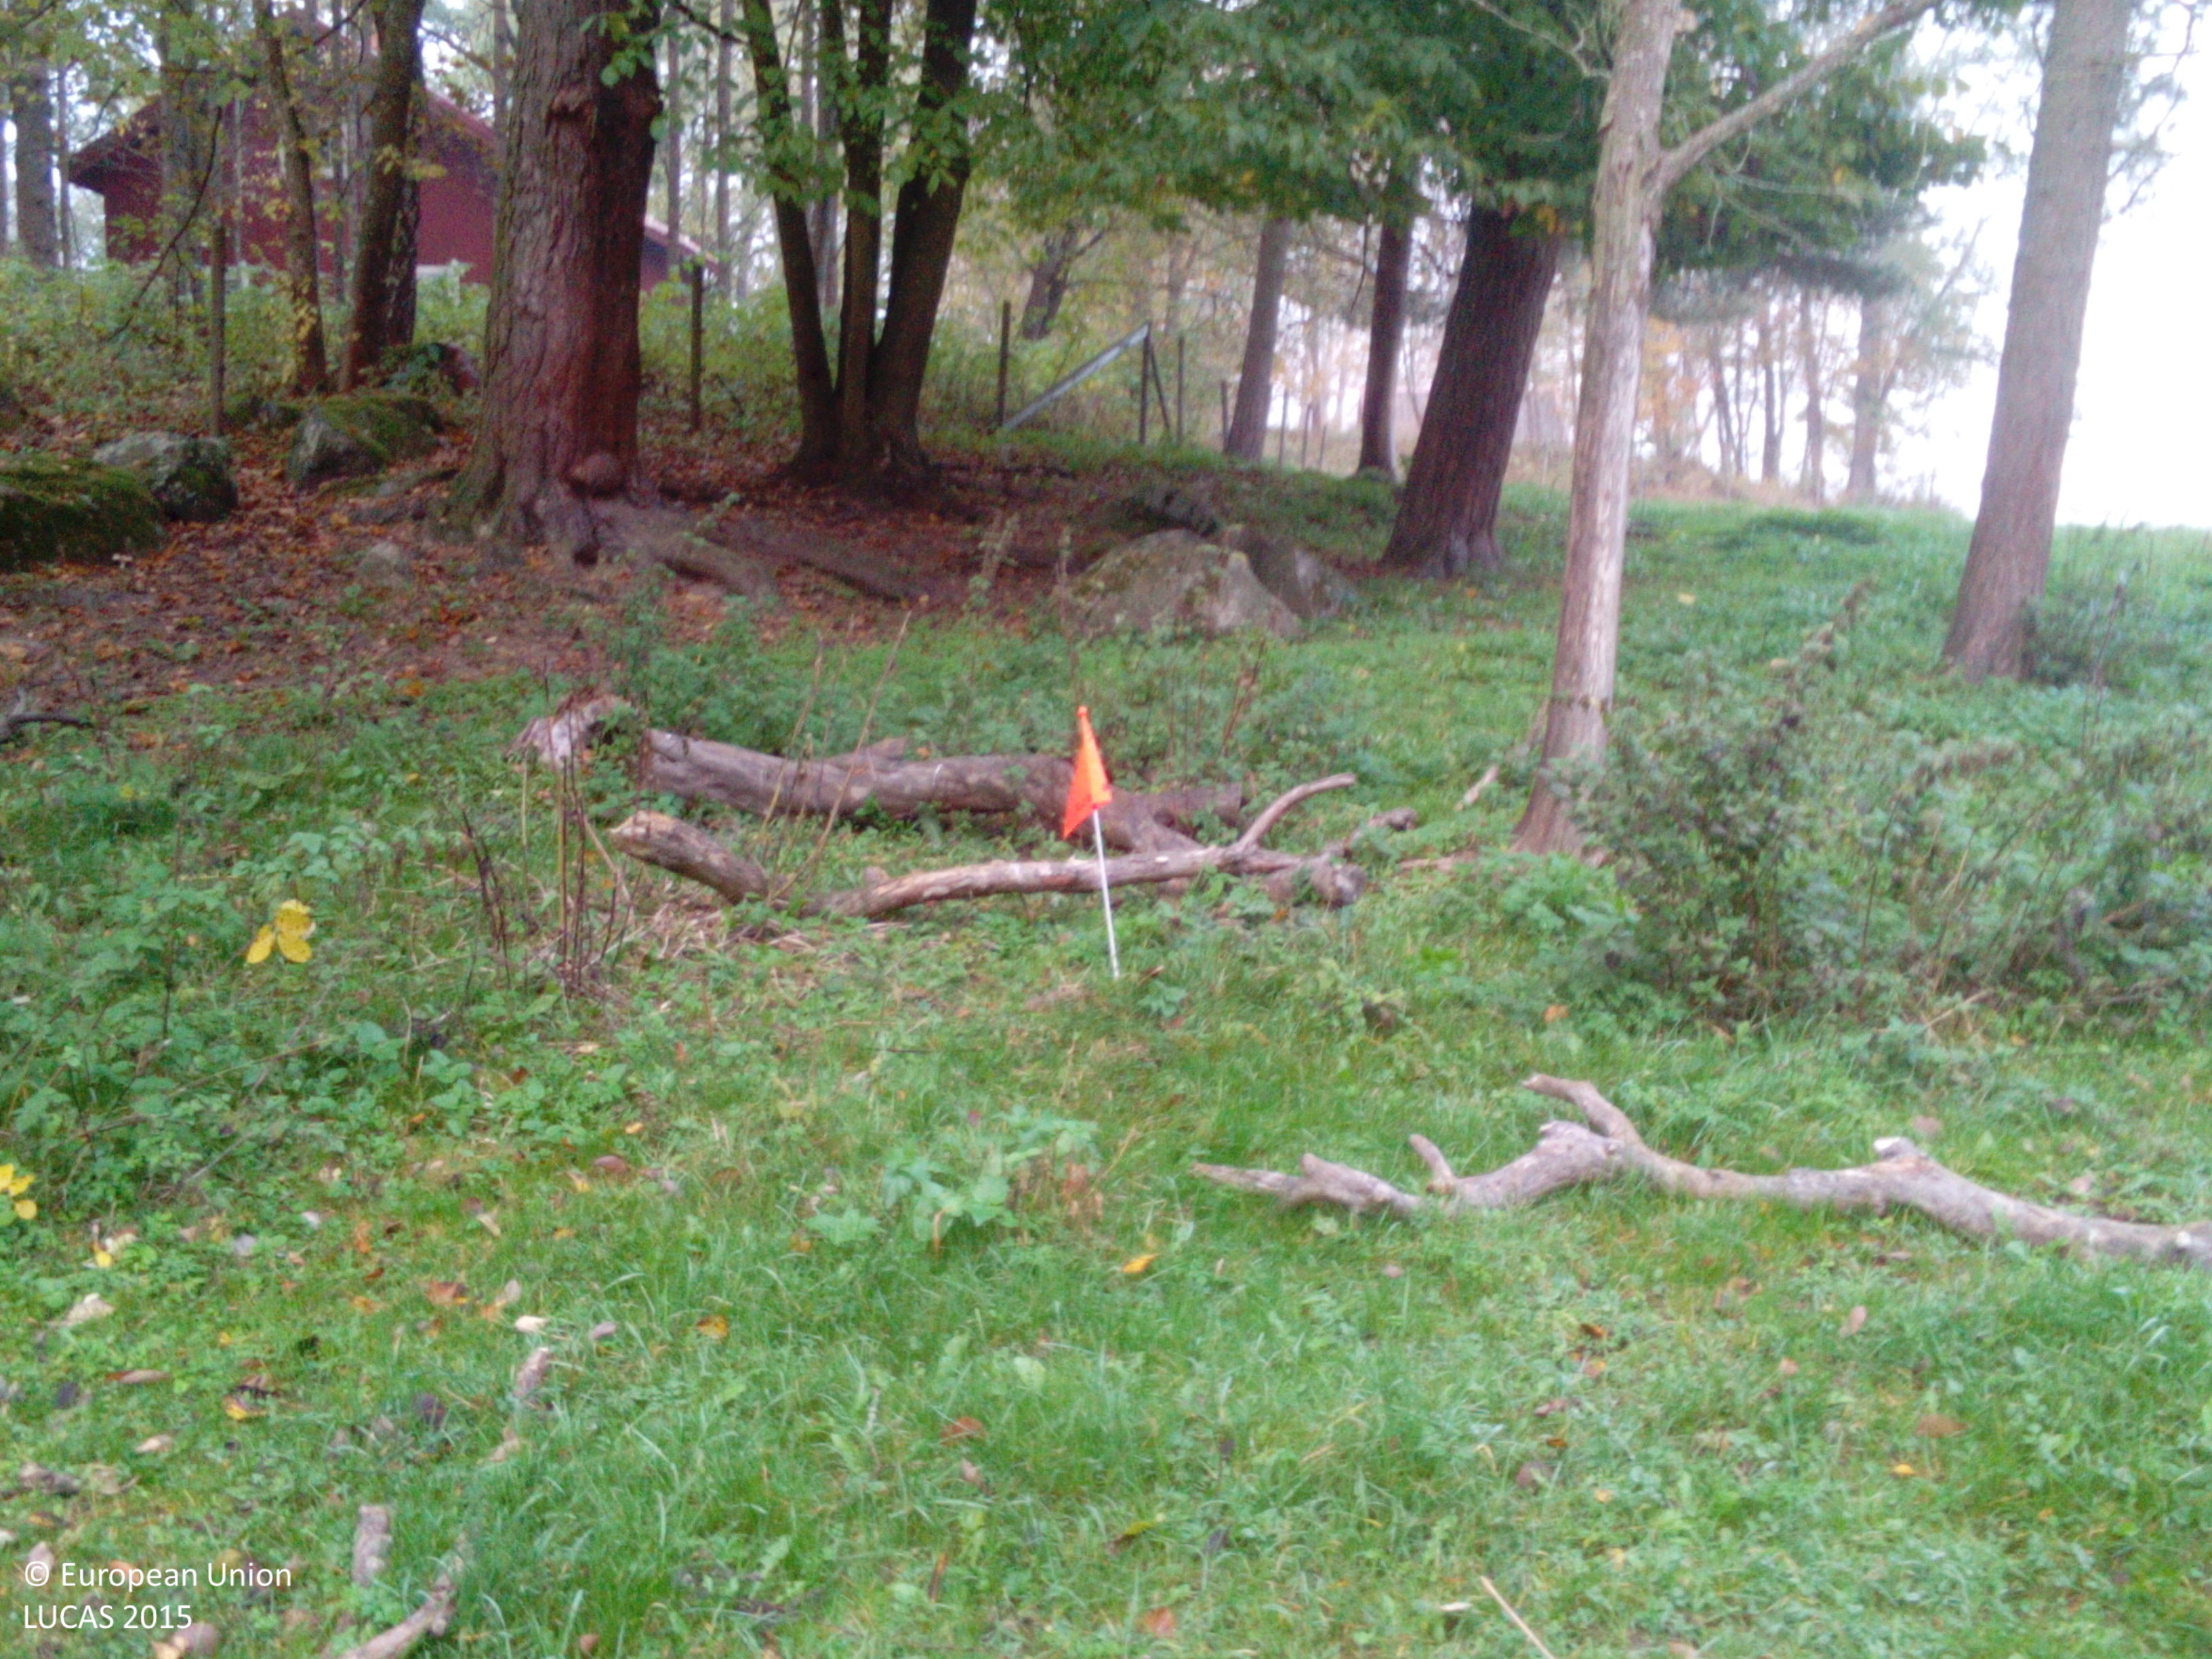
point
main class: Grassland
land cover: Grassland with sparse tree/shrub cover
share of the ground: > 75 %
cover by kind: herbaceous plants 95 %, broadleaved forest trees 5 %
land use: Agriculture (excluding fallow land and kitchen gardens)
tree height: > 5 m
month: October
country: SE
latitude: 59.0066
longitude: 16.3838
